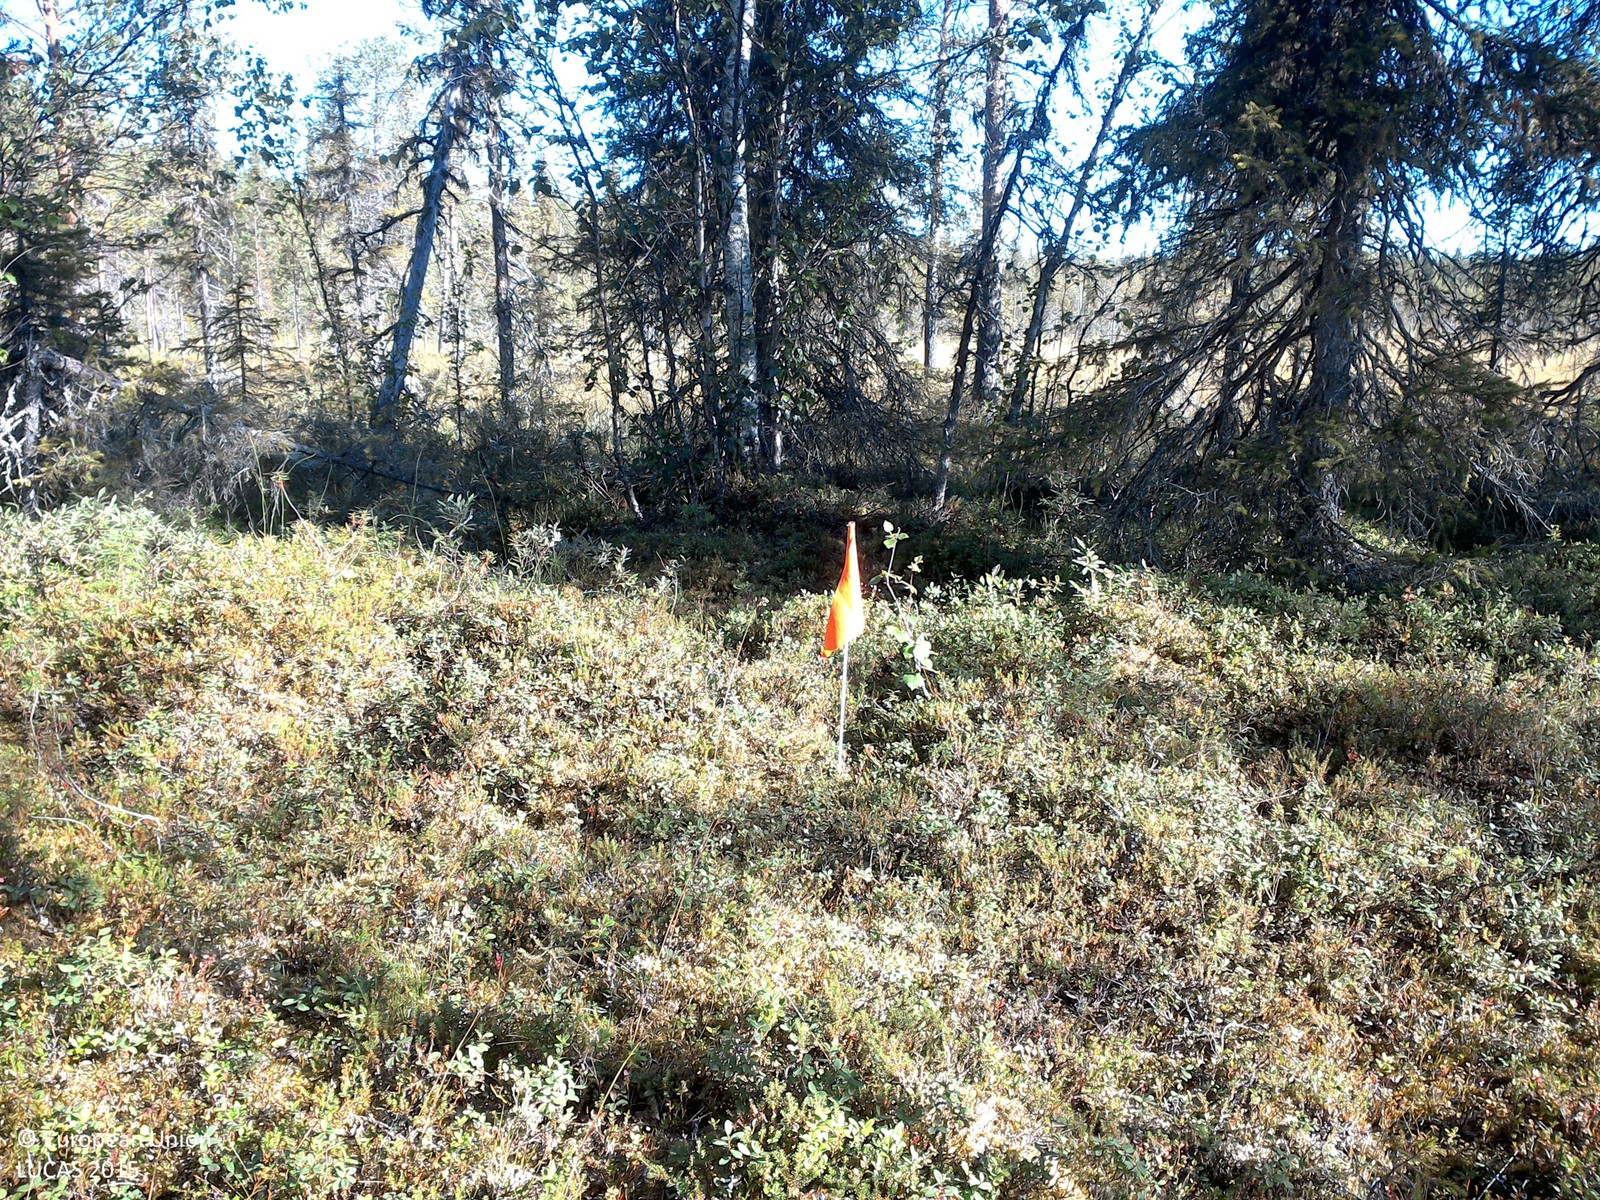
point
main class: Woodland
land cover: Spruce dominated mixed woodland
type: boreal forest
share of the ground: 25 - 50 %
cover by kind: shrubs 65 %, coniferous forest trees 20 %, broadleaved forest trees 10 %, lichens and mosses 5 %
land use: Forestry
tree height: > 5 m
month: August
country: SE
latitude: 67.1023
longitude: 21.3544
